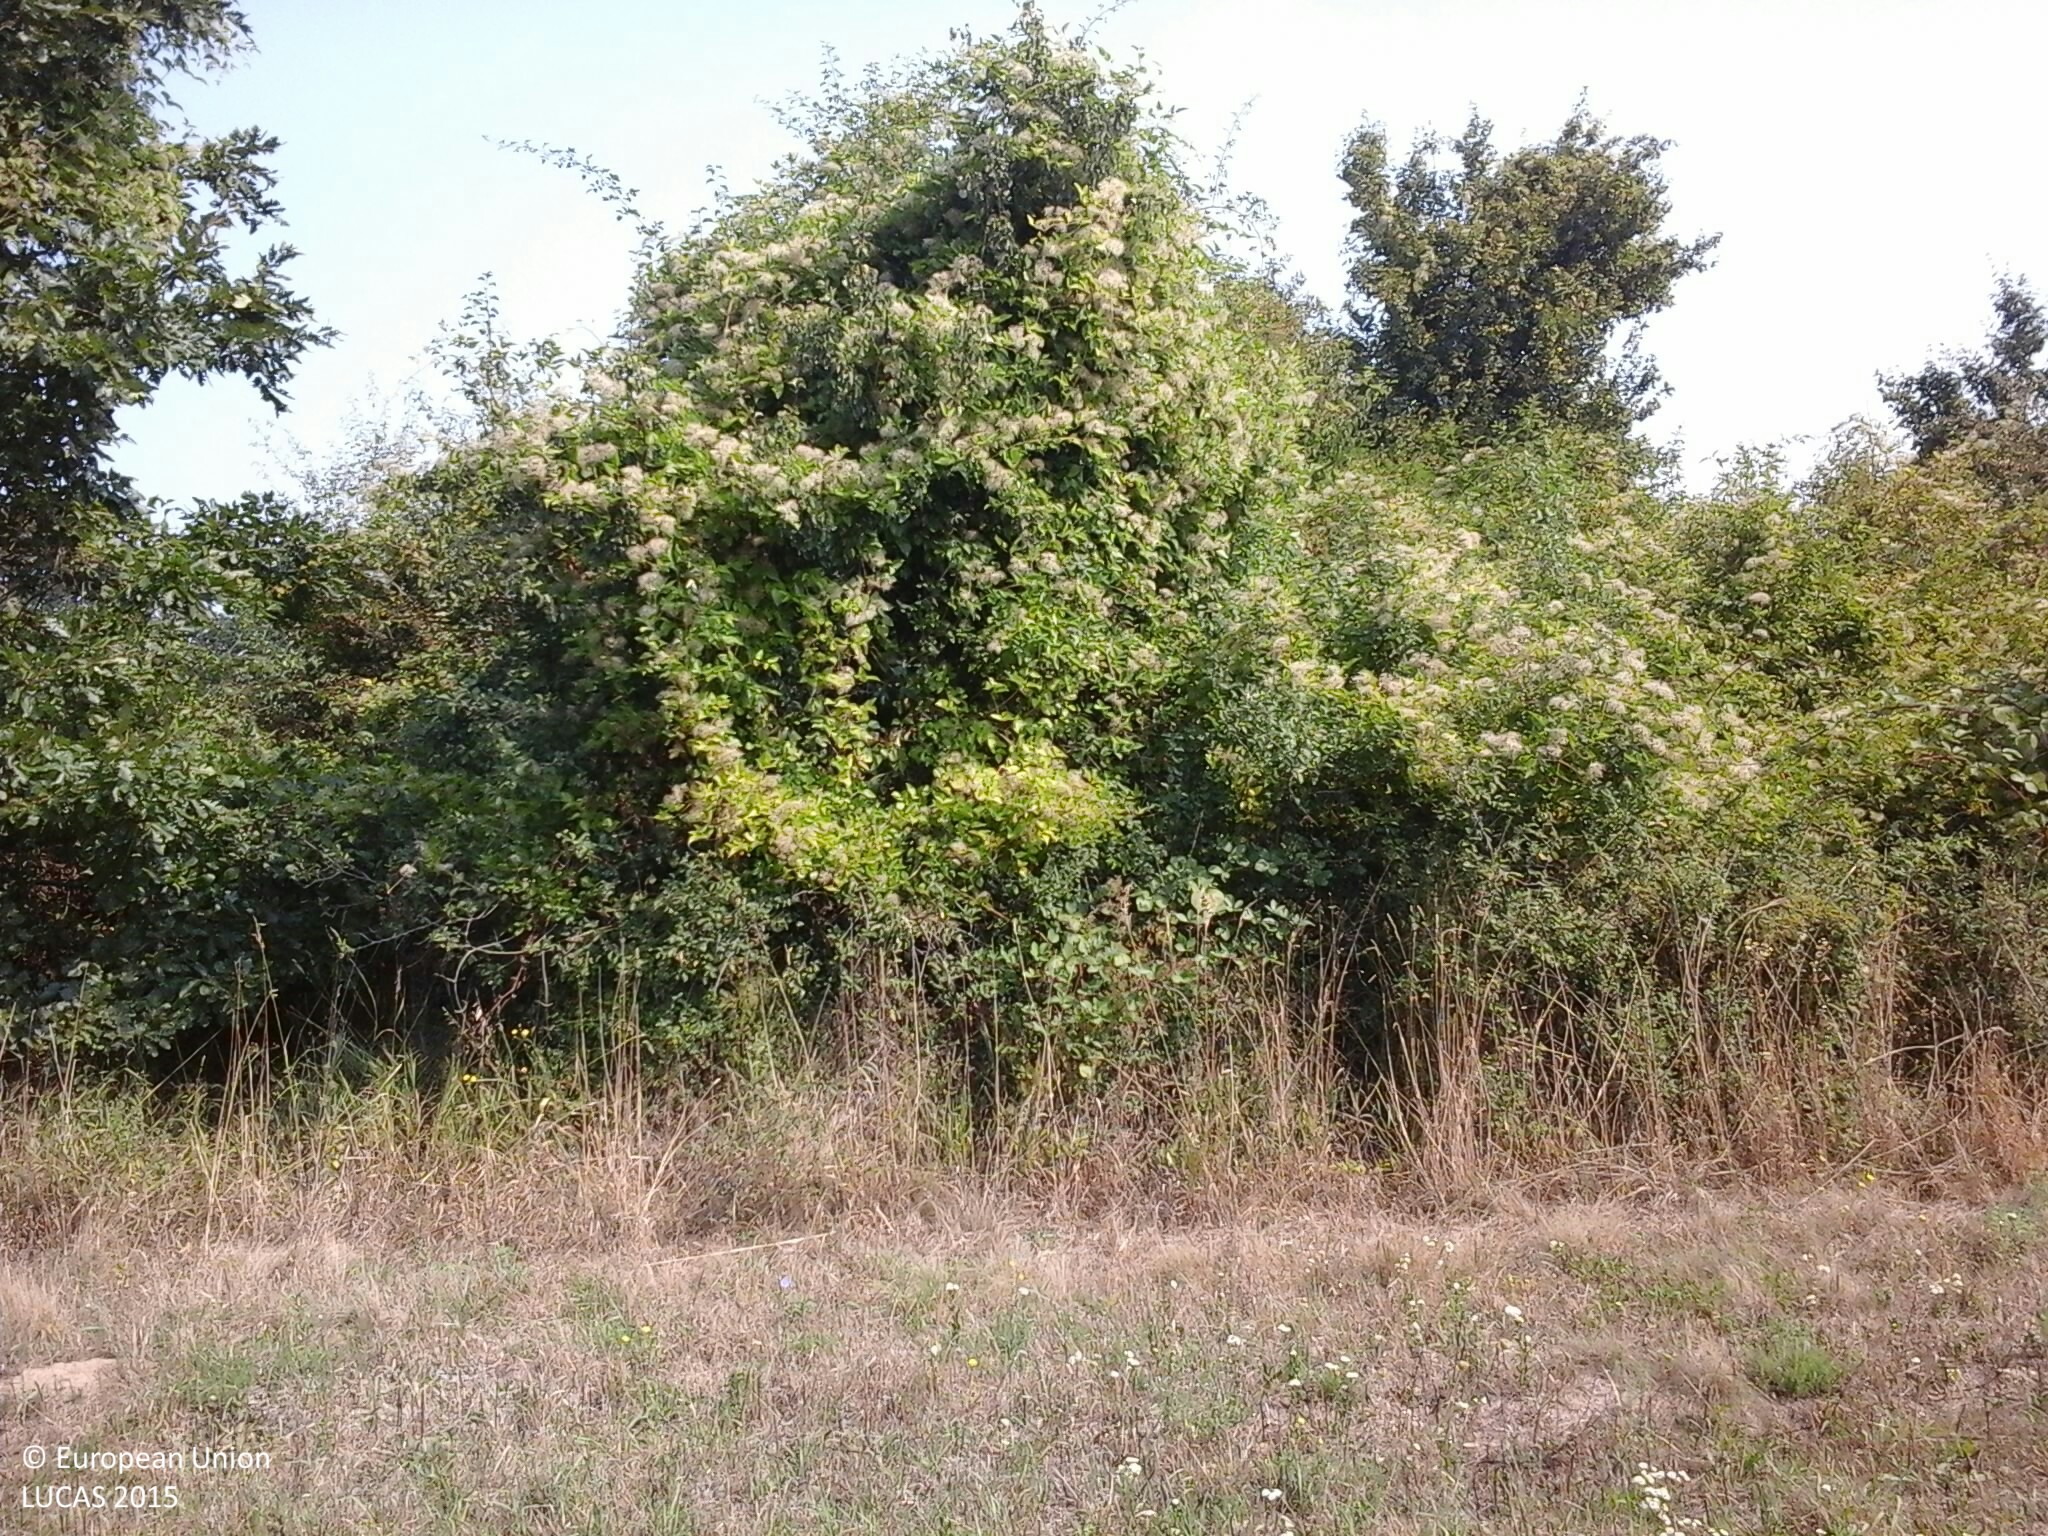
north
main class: Grassland
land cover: Grassland without tree/shrub cover
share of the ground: > 75 %
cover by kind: herbaceous plants 100 %
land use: Agriculture (excluding fallow land and kitchen gardens)
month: August
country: HU
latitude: 47.8739
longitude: 19.2057
